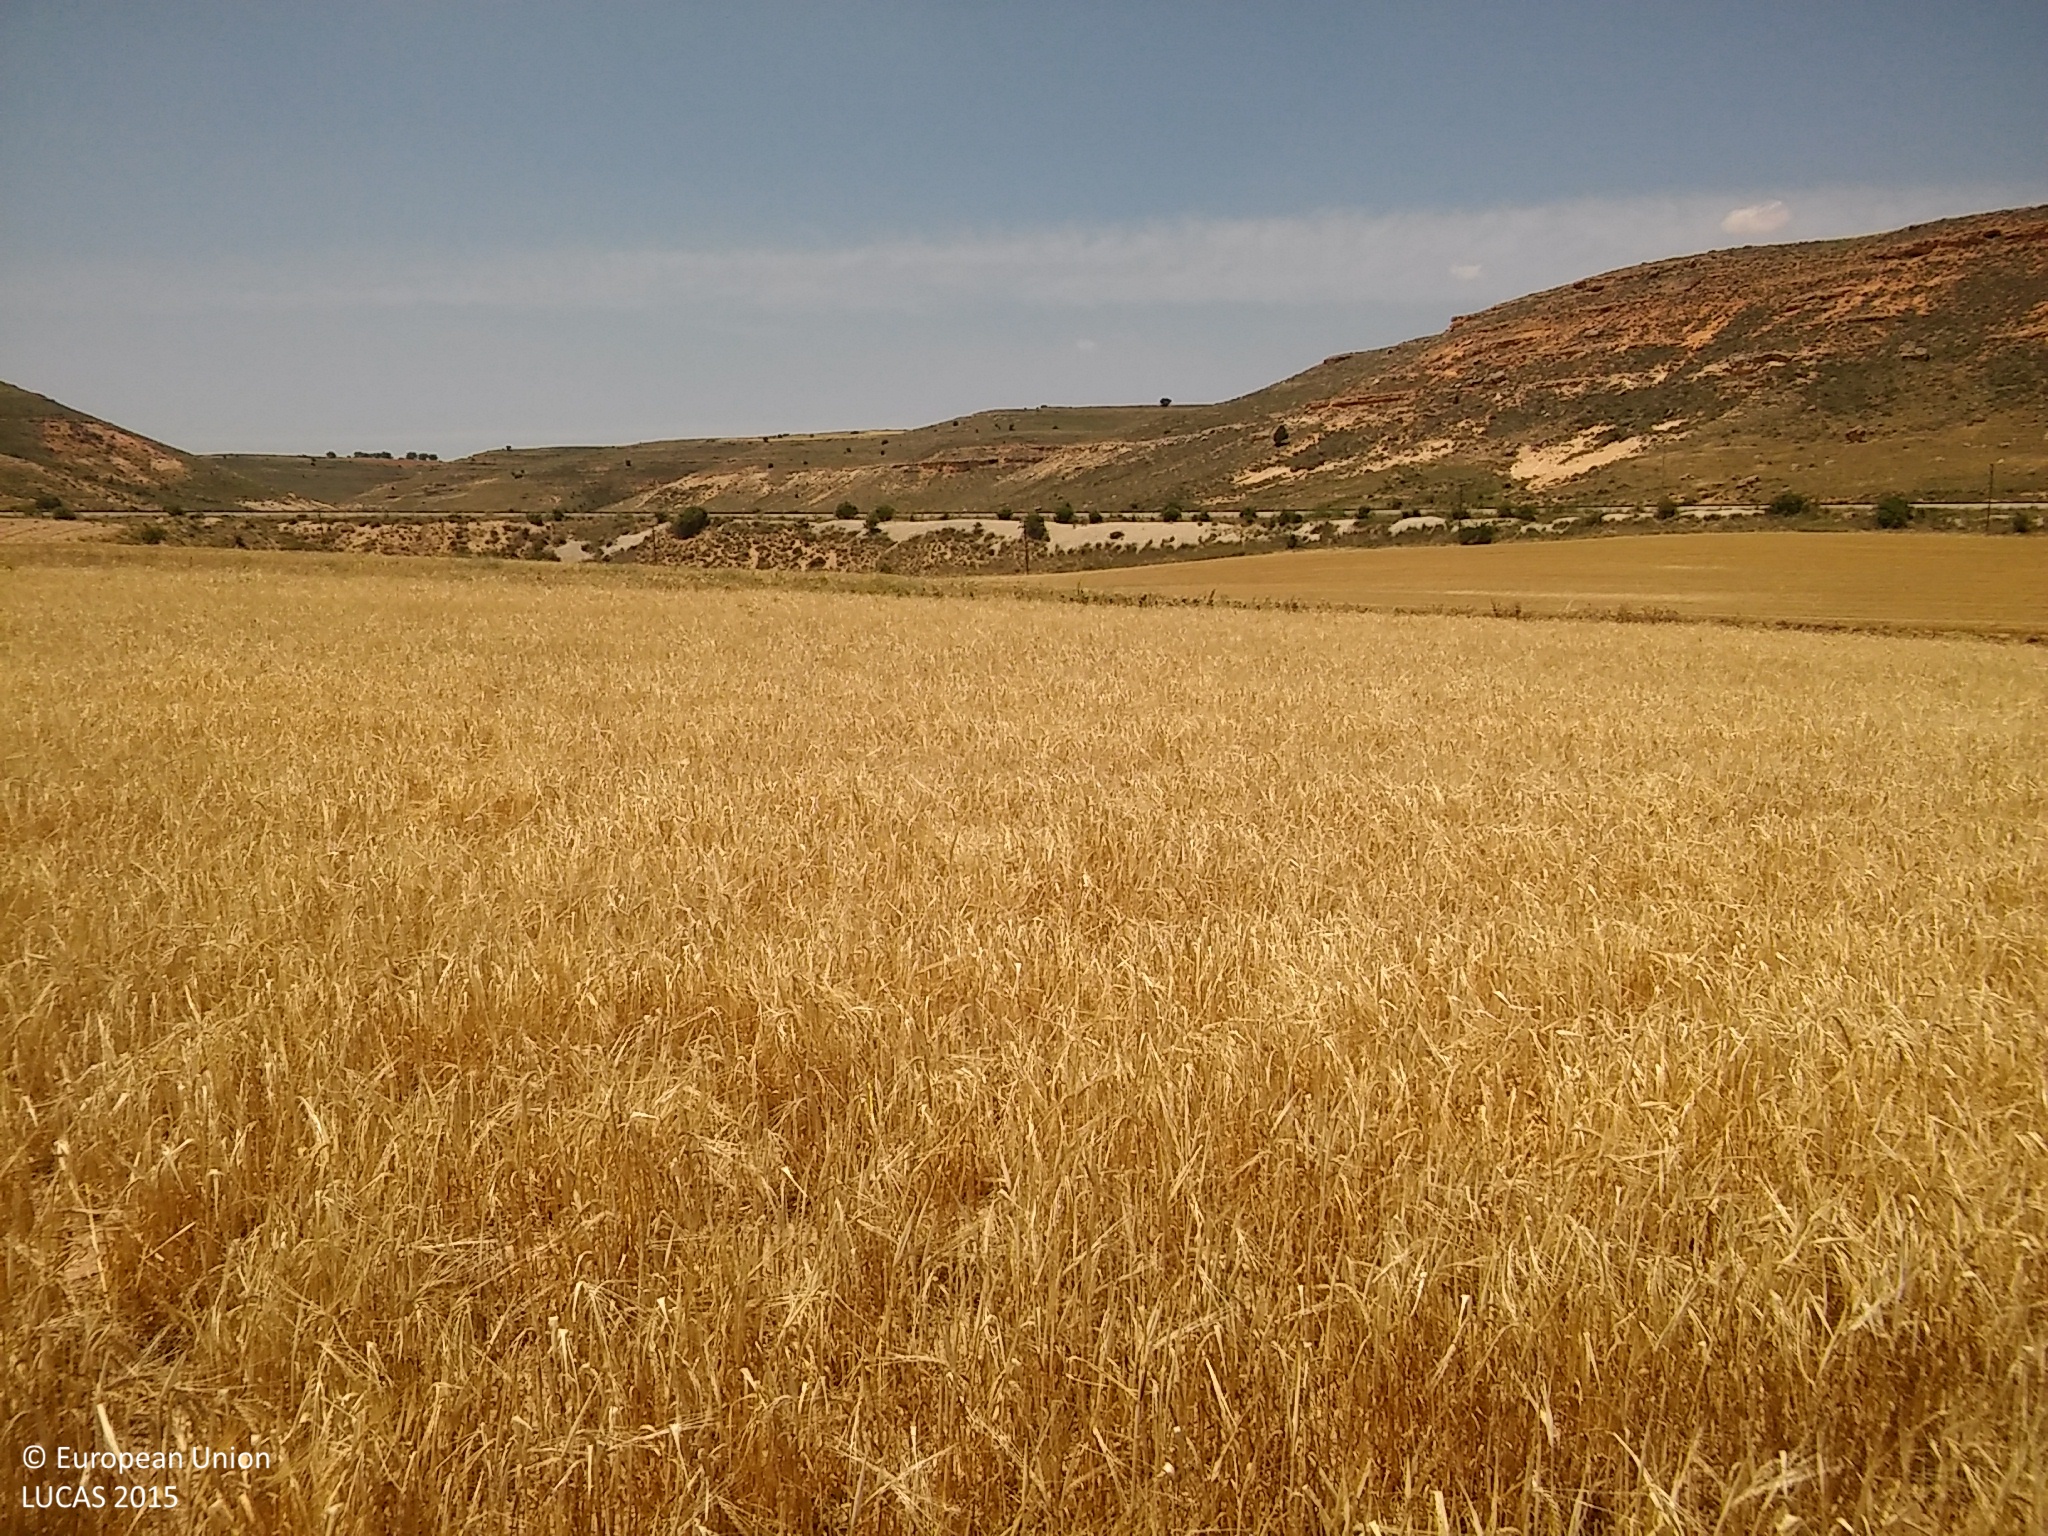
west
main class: Cropland
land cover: Barley
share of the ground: > 75 %
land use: Agriculture (excluding fallow land and kitchen gardens)
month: July
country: ES
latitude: 41.4833
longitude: -3.5459
